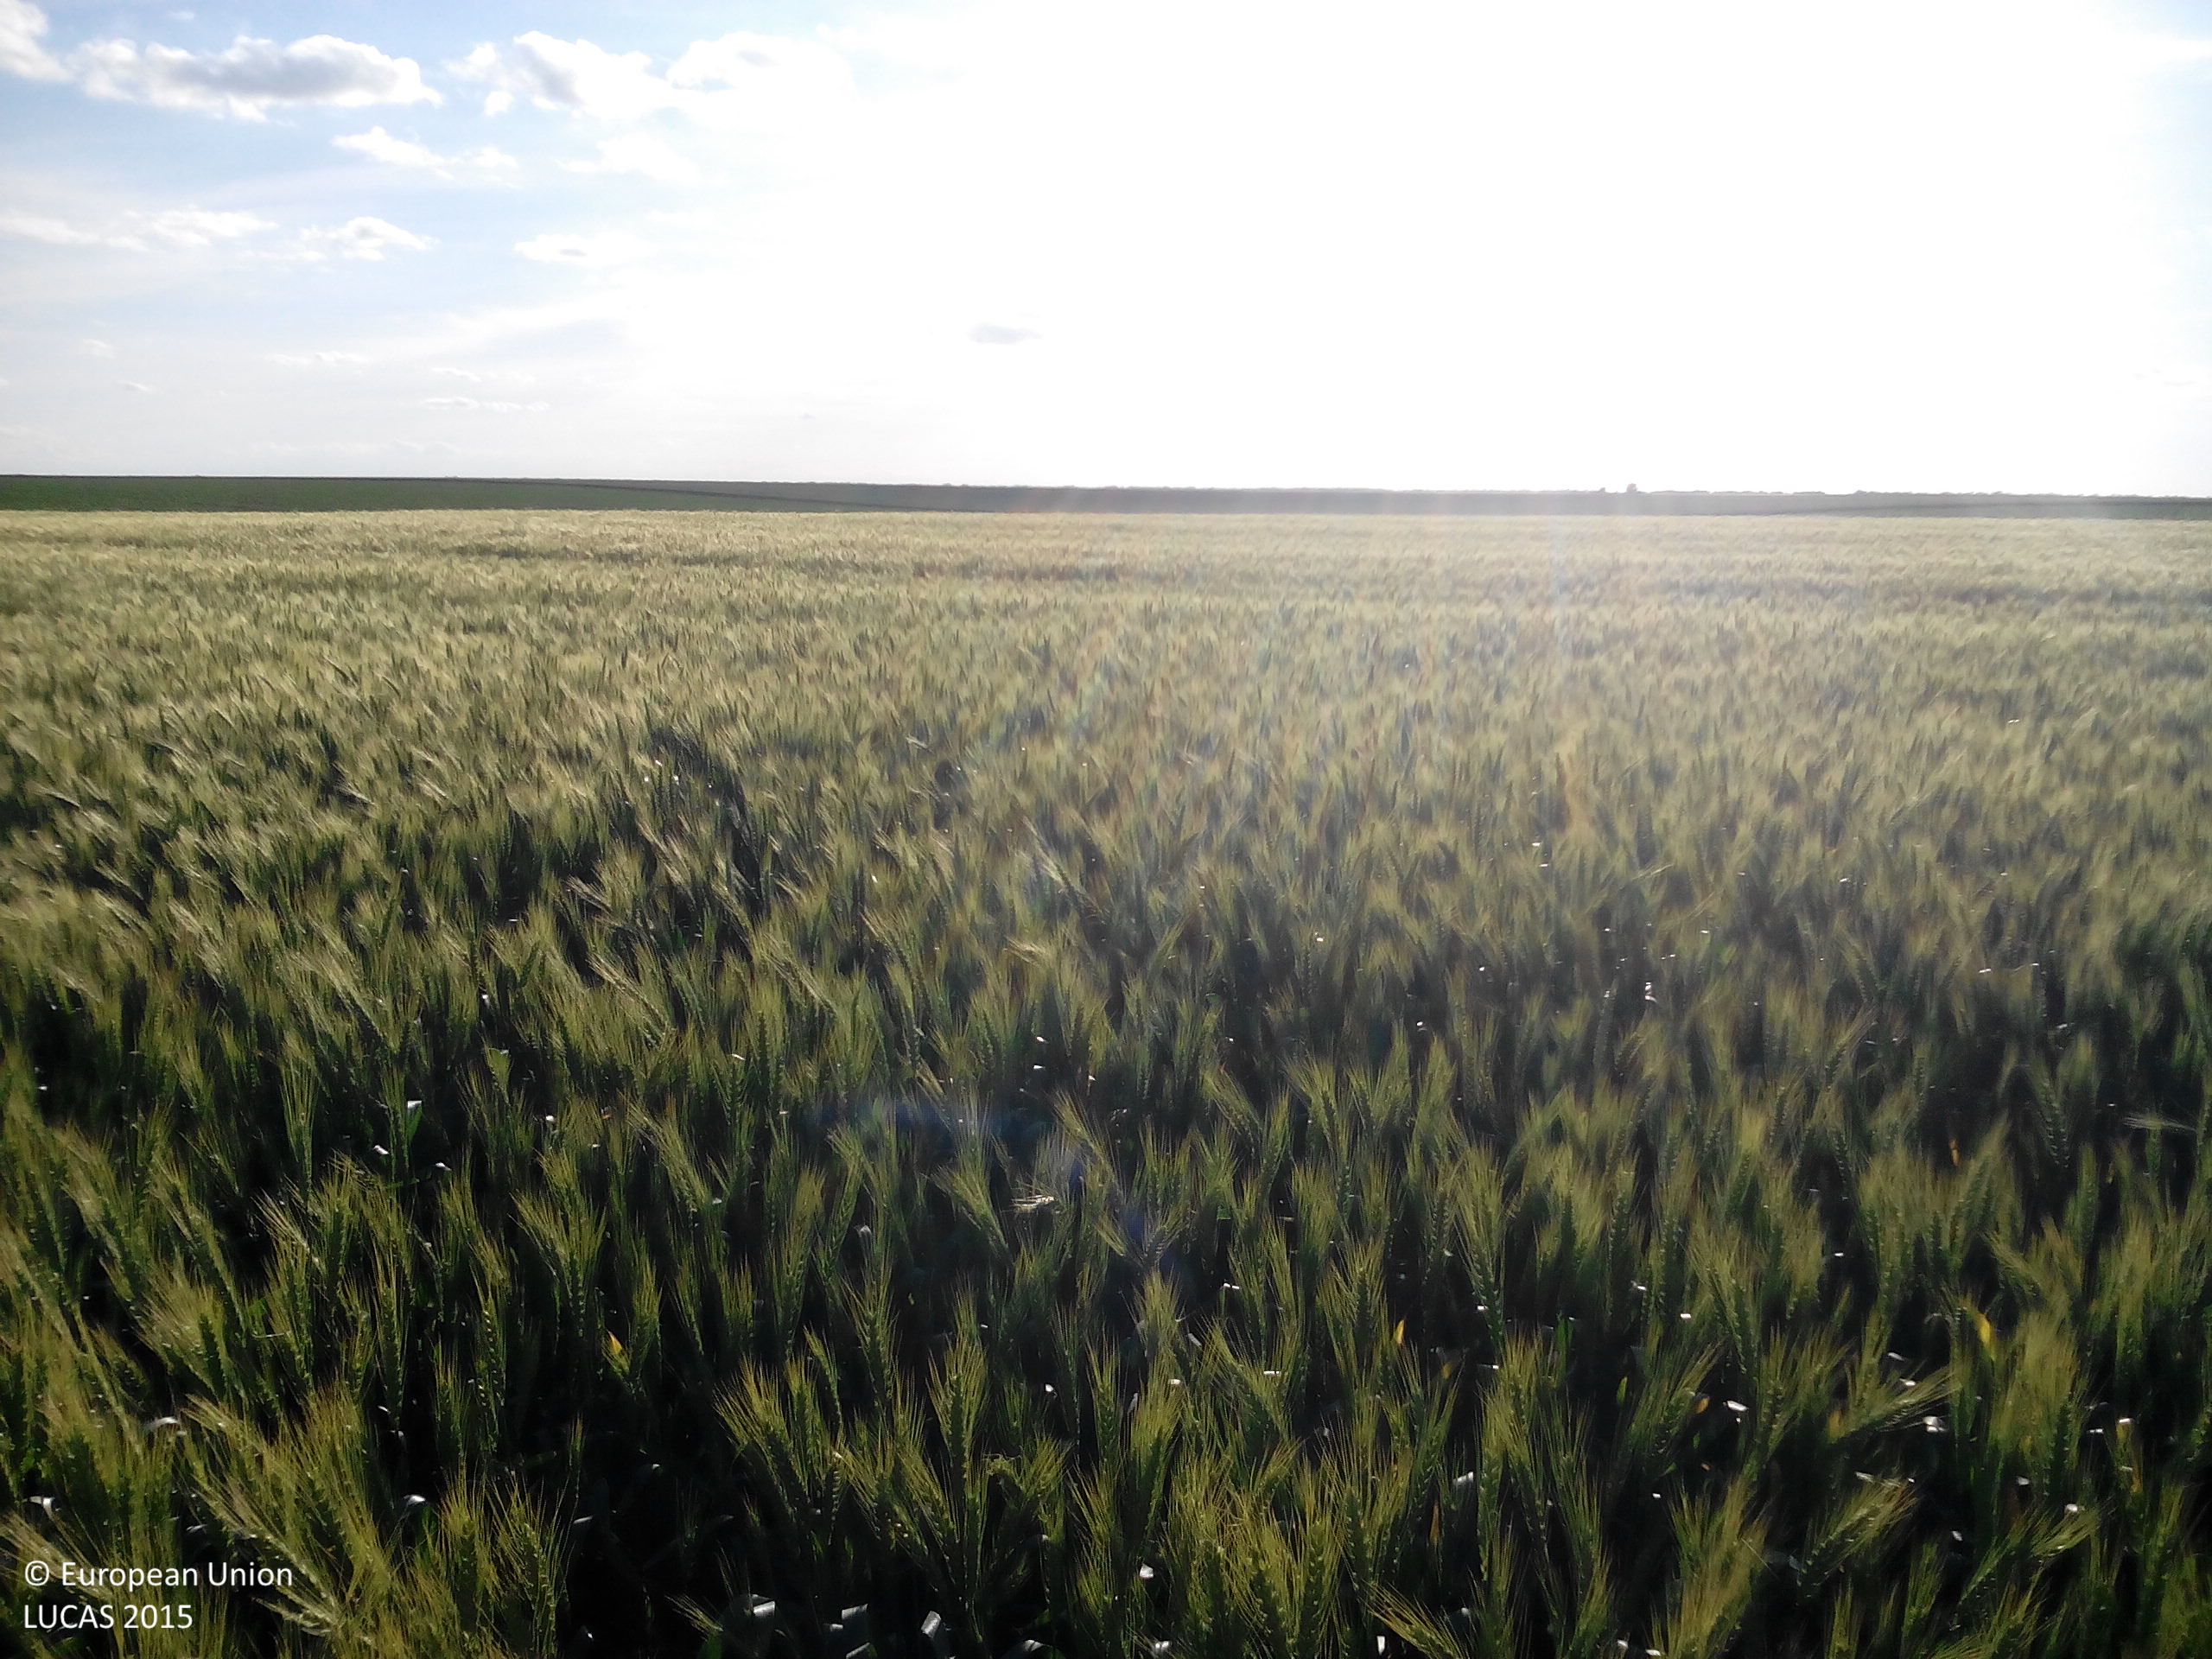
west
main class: Cropland
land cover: Common wheat
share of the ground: > 75 %
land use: Agriculture (excluding fallow land and kitchen gardens)
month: May
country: BG
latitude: 43.5994
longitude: 24.1159
